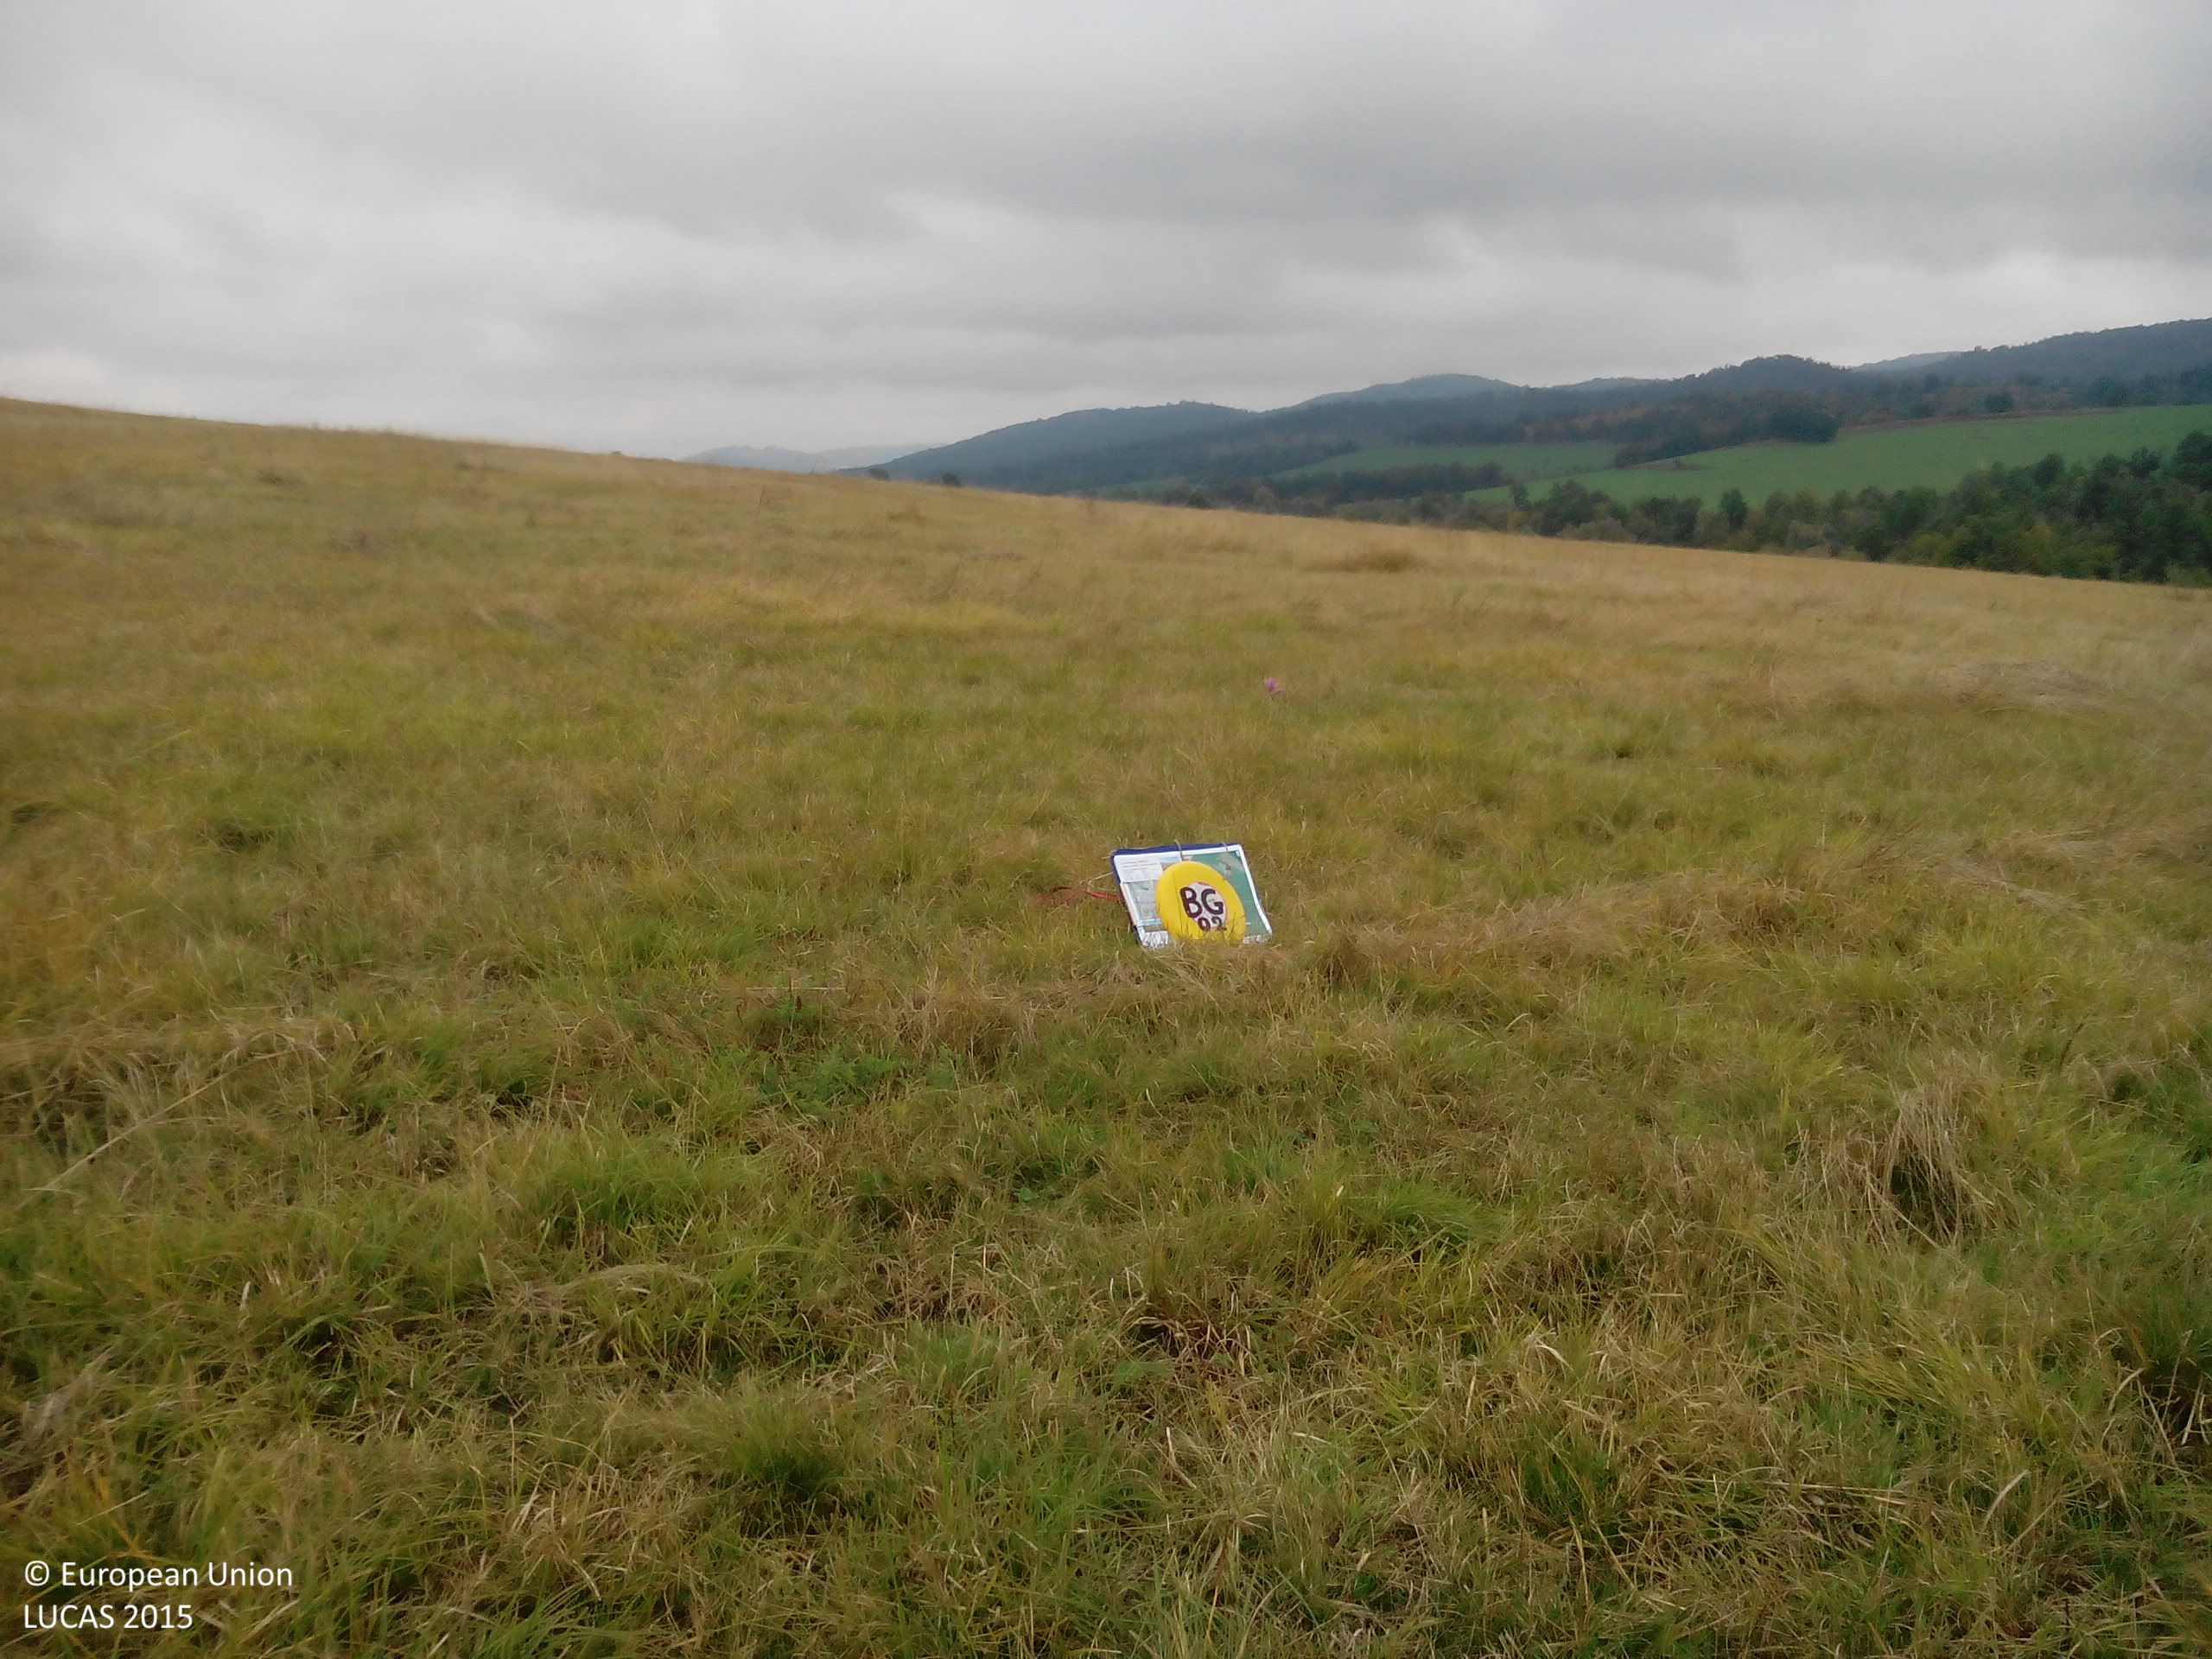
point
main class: Grassland
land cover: Grassland without tree/shrub cover
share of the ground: > 75 %
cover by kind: herbaceous plants 100 %
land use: Agriculture (excluding fallow land and kitchen gardens)
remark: Harvested field
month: October
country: BG
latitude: 43.1294
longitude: 24.0762
